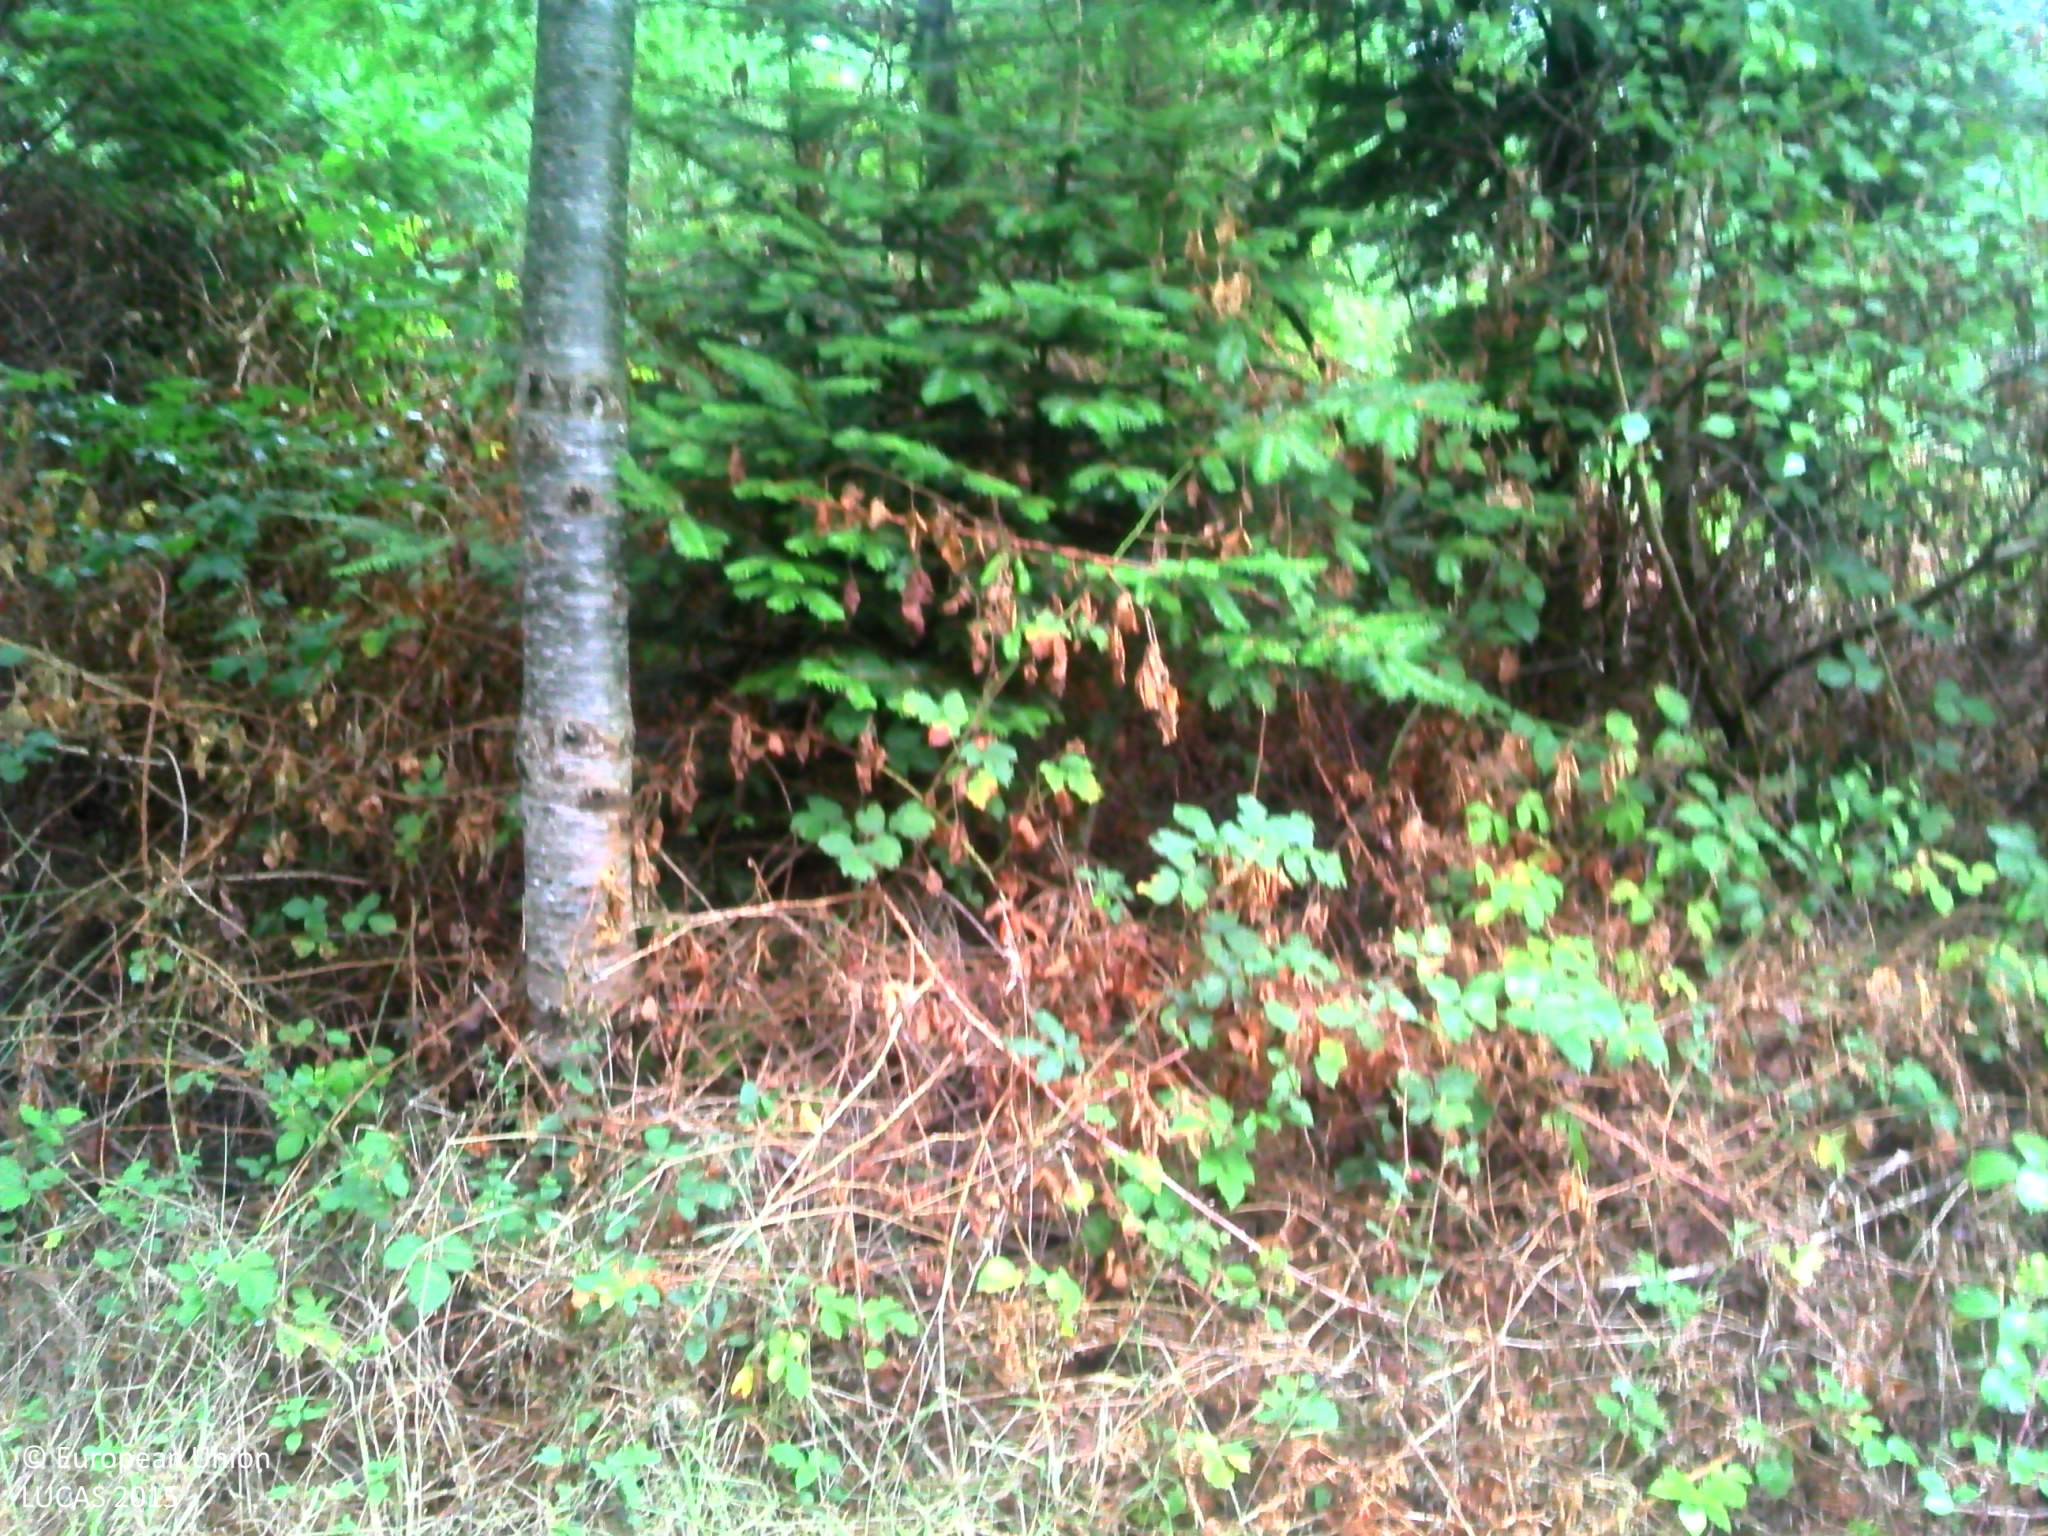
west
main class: Woodland
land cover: Spruce dominated coniferous woodland
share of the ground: > 75 %
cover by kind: coniferous forest trees 95 %, broadleaved forest trees 5 %
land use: Forestry
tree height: > 5 m
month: August
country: FR
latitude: 46.0063
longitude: 0.9873
